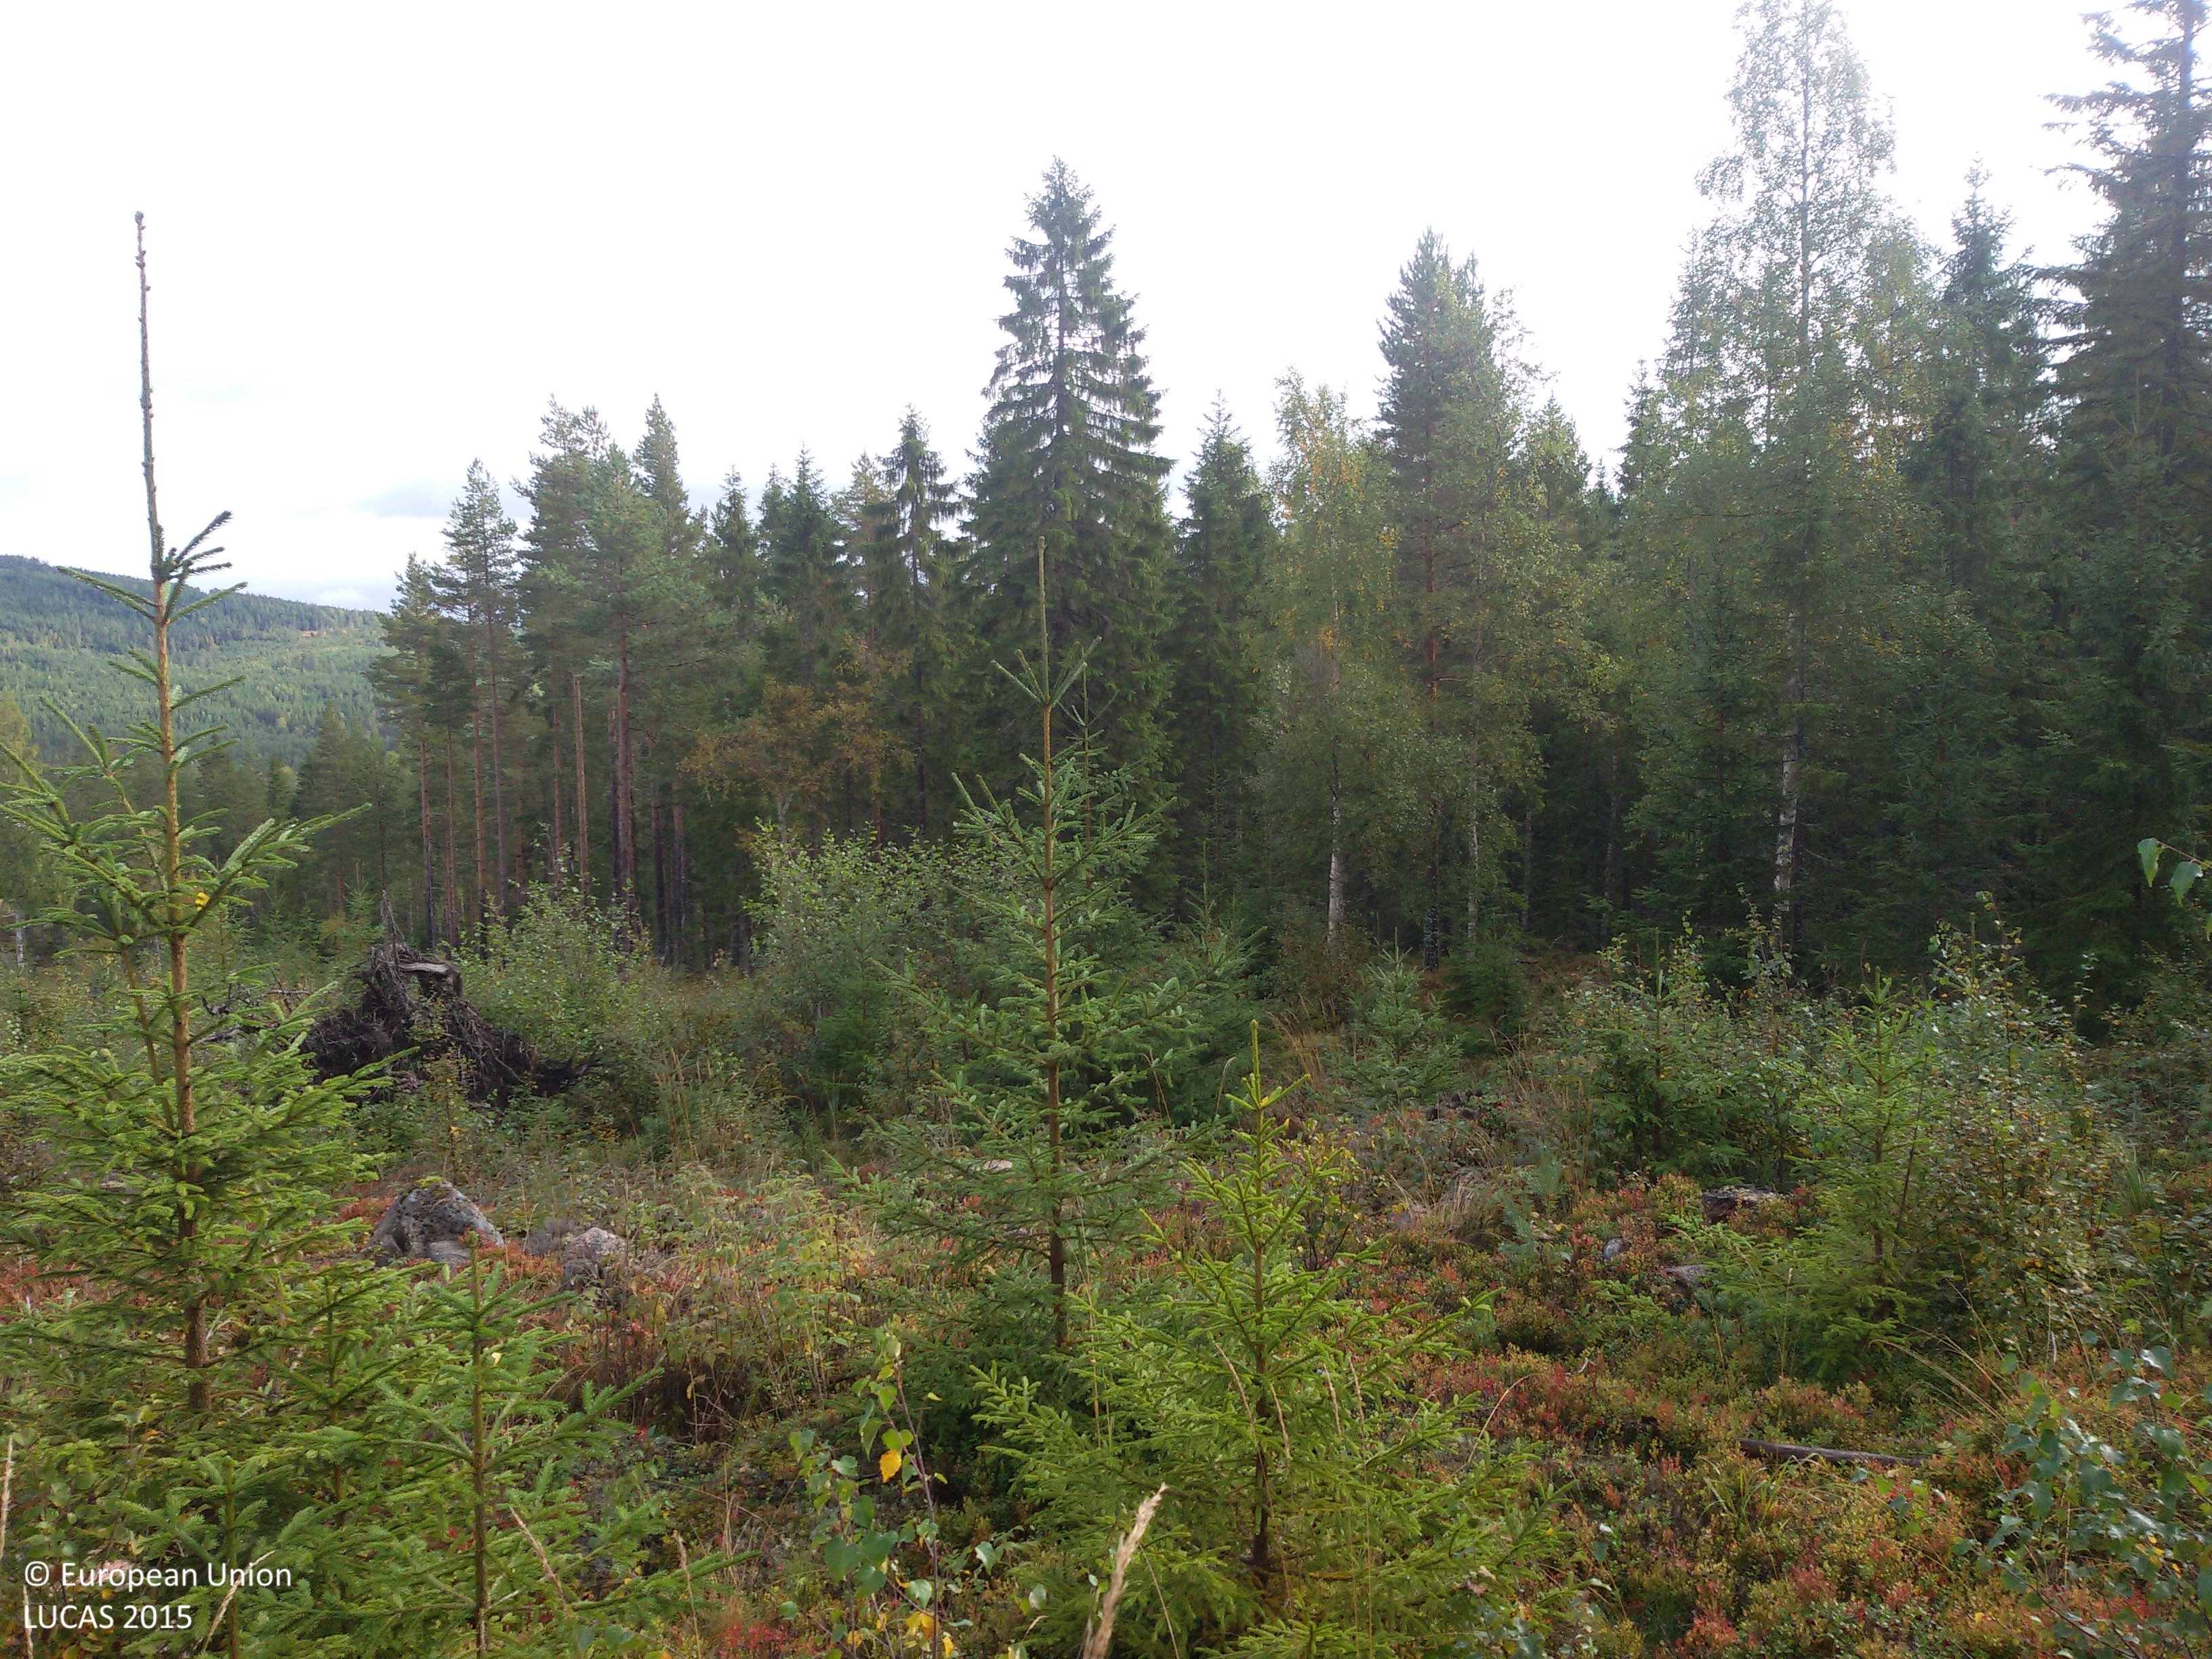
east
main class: Woodland
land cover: Spruce dominated mixed woodland
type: boreal forest
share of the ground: 50 - 75 %
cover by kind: coniferous forest trees 30 %, shrubs 30 %, broadleaved forest trees 20 %, herbaceous plants 20 %
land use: Forestry
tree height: < 5 m
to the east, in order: Spruce dominated mixed woodland; Pine dominated coniferous woodland; Spruce dominated mixed woodland
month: September
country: SE
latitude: 60.8091
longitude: 14.6007
